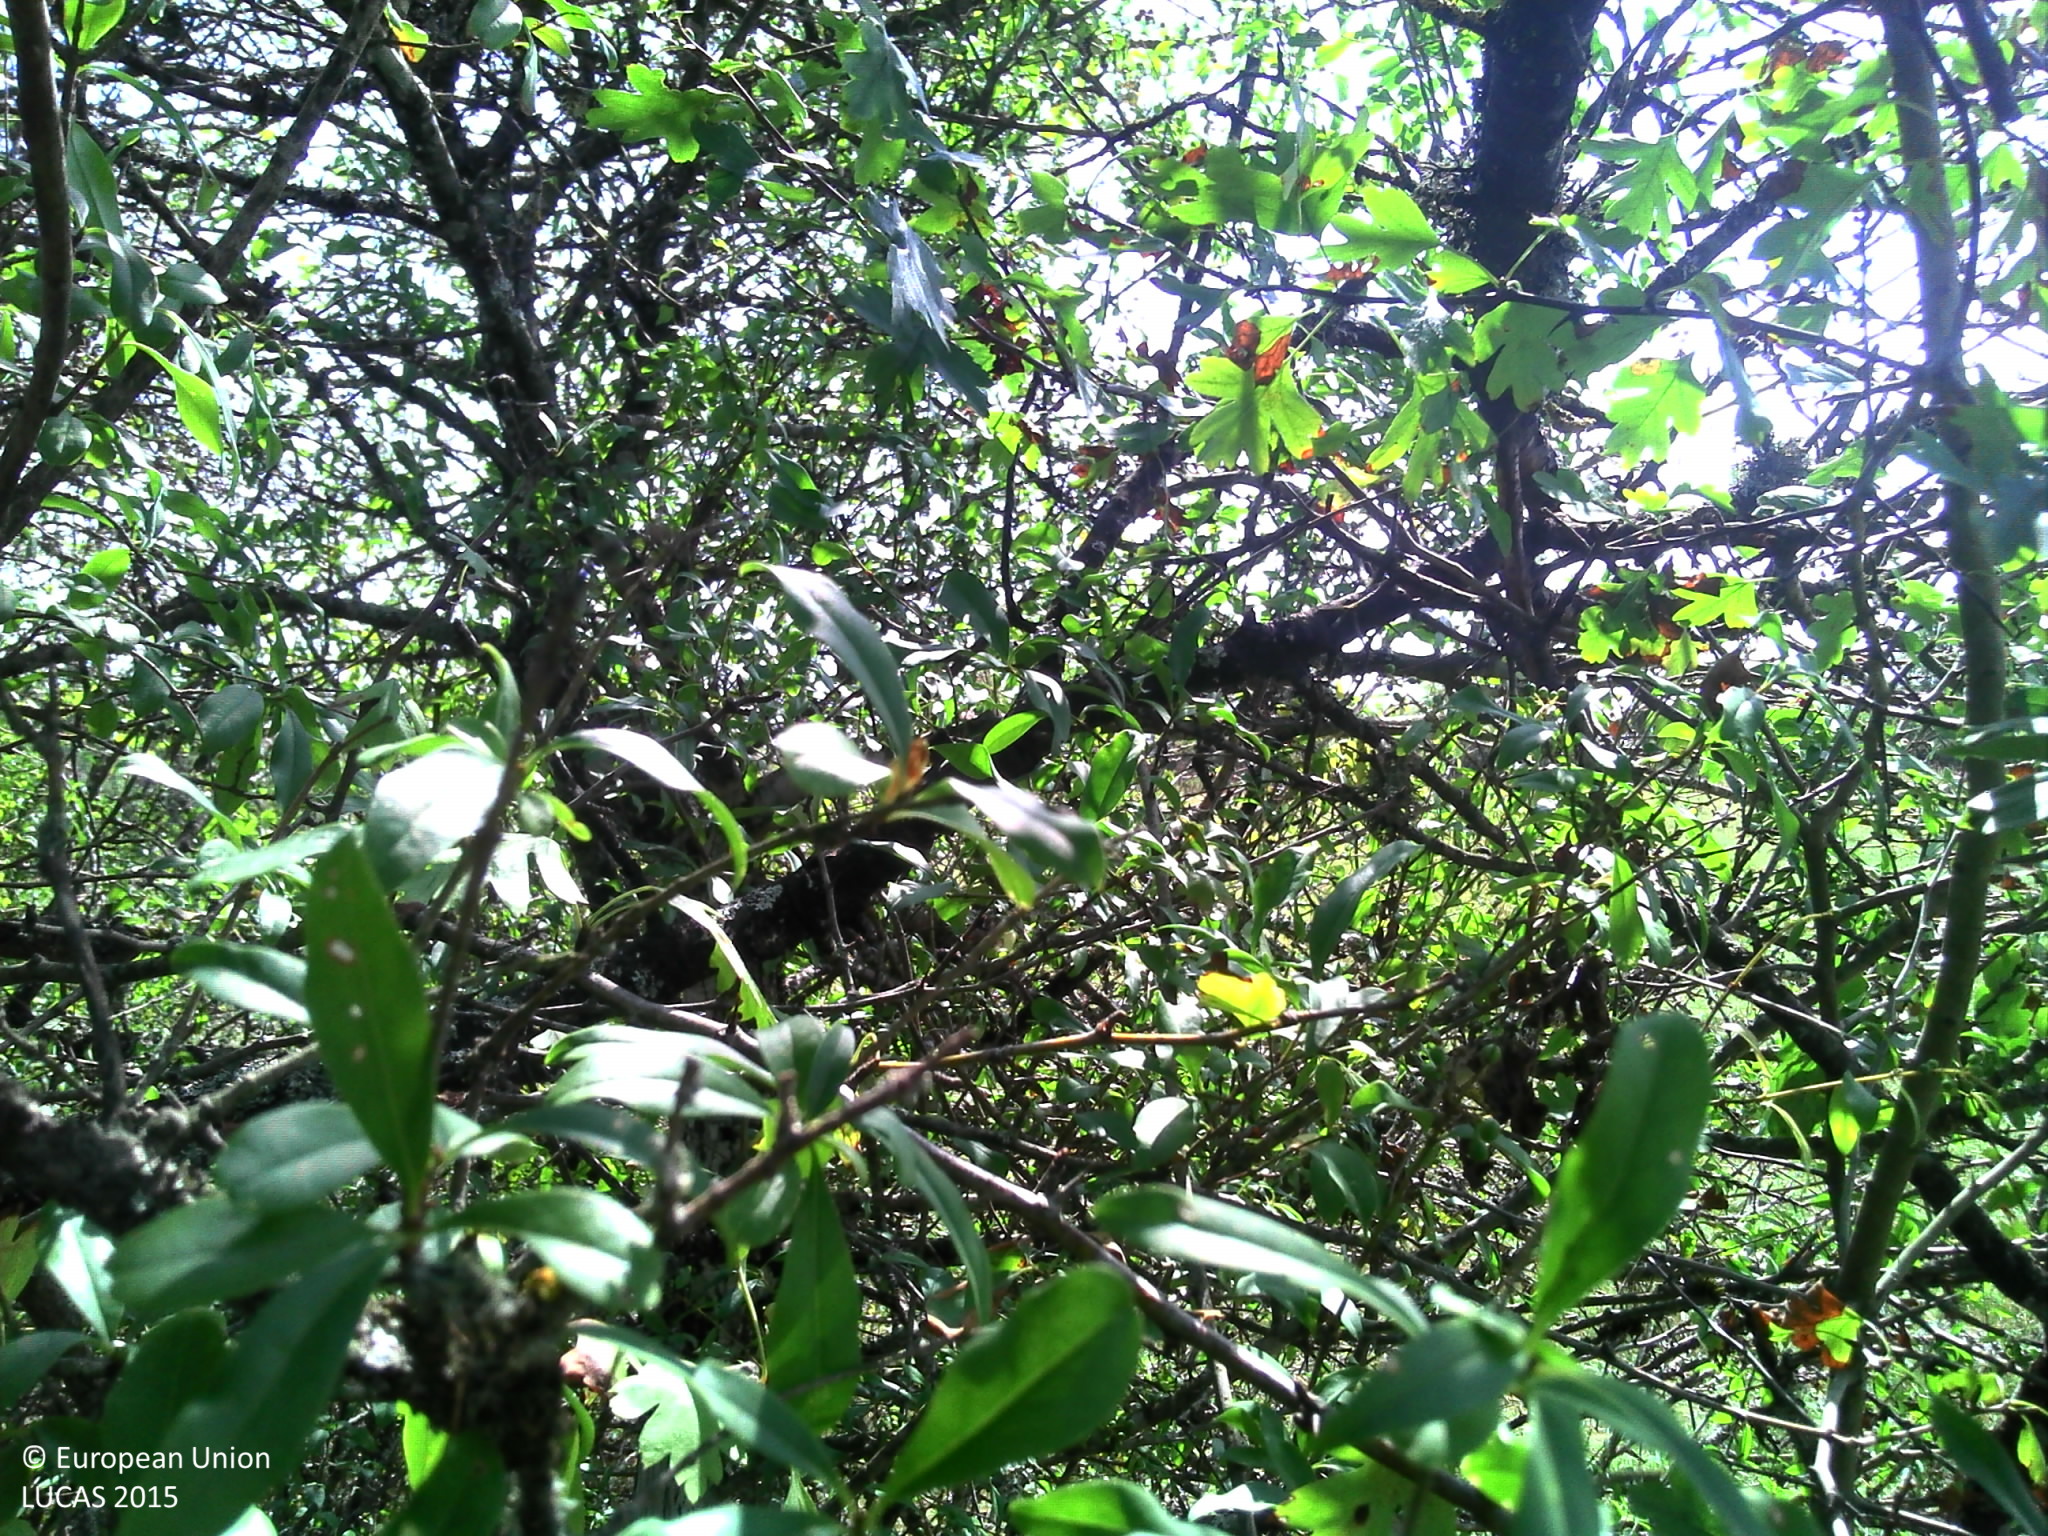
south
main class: Woodland
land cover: Broadleaved woodland
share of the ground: > 75 %
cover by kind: broadleaved forest trees 70 %, shrubs 15 %, herbaceous plants 15 %
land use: Semi-natural and natural areas not in use
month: August
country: FR
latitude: 47.2151
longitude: 4.7582
